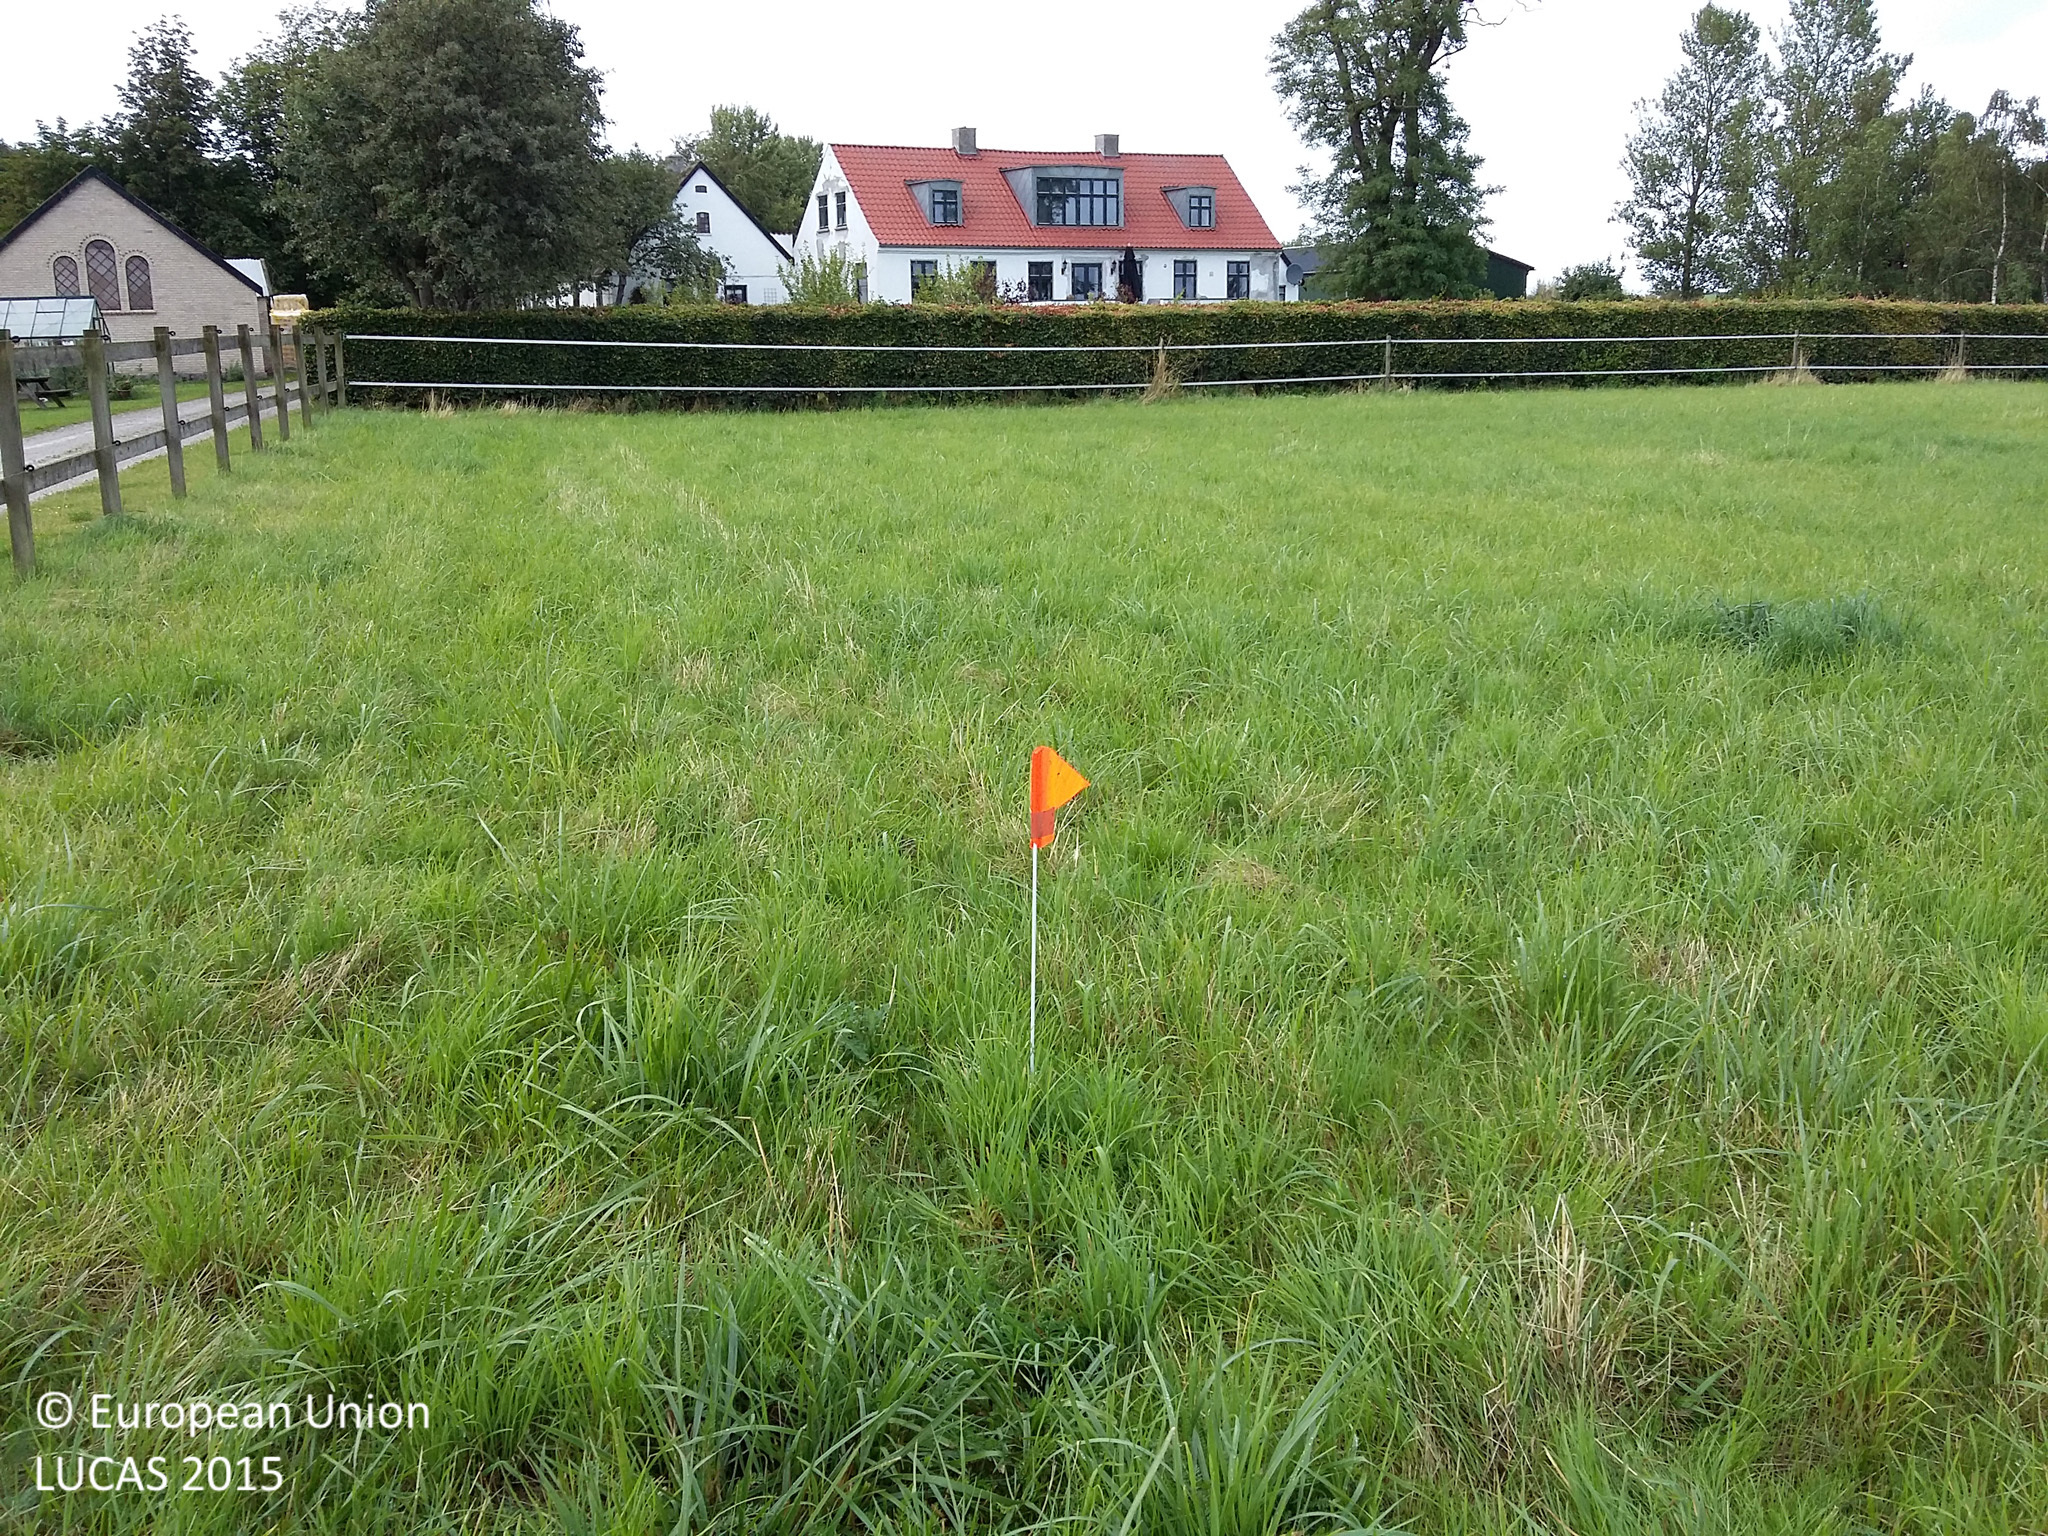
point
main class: Grassland
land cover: Grassland without tree/shrub cover
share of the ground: > 75 %
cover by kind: herbaceous plants 100 %
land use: Agriculture (excluding fallow land and kitchen gardens)
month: July
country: DK
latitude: 55.8280
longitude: 12.1532
